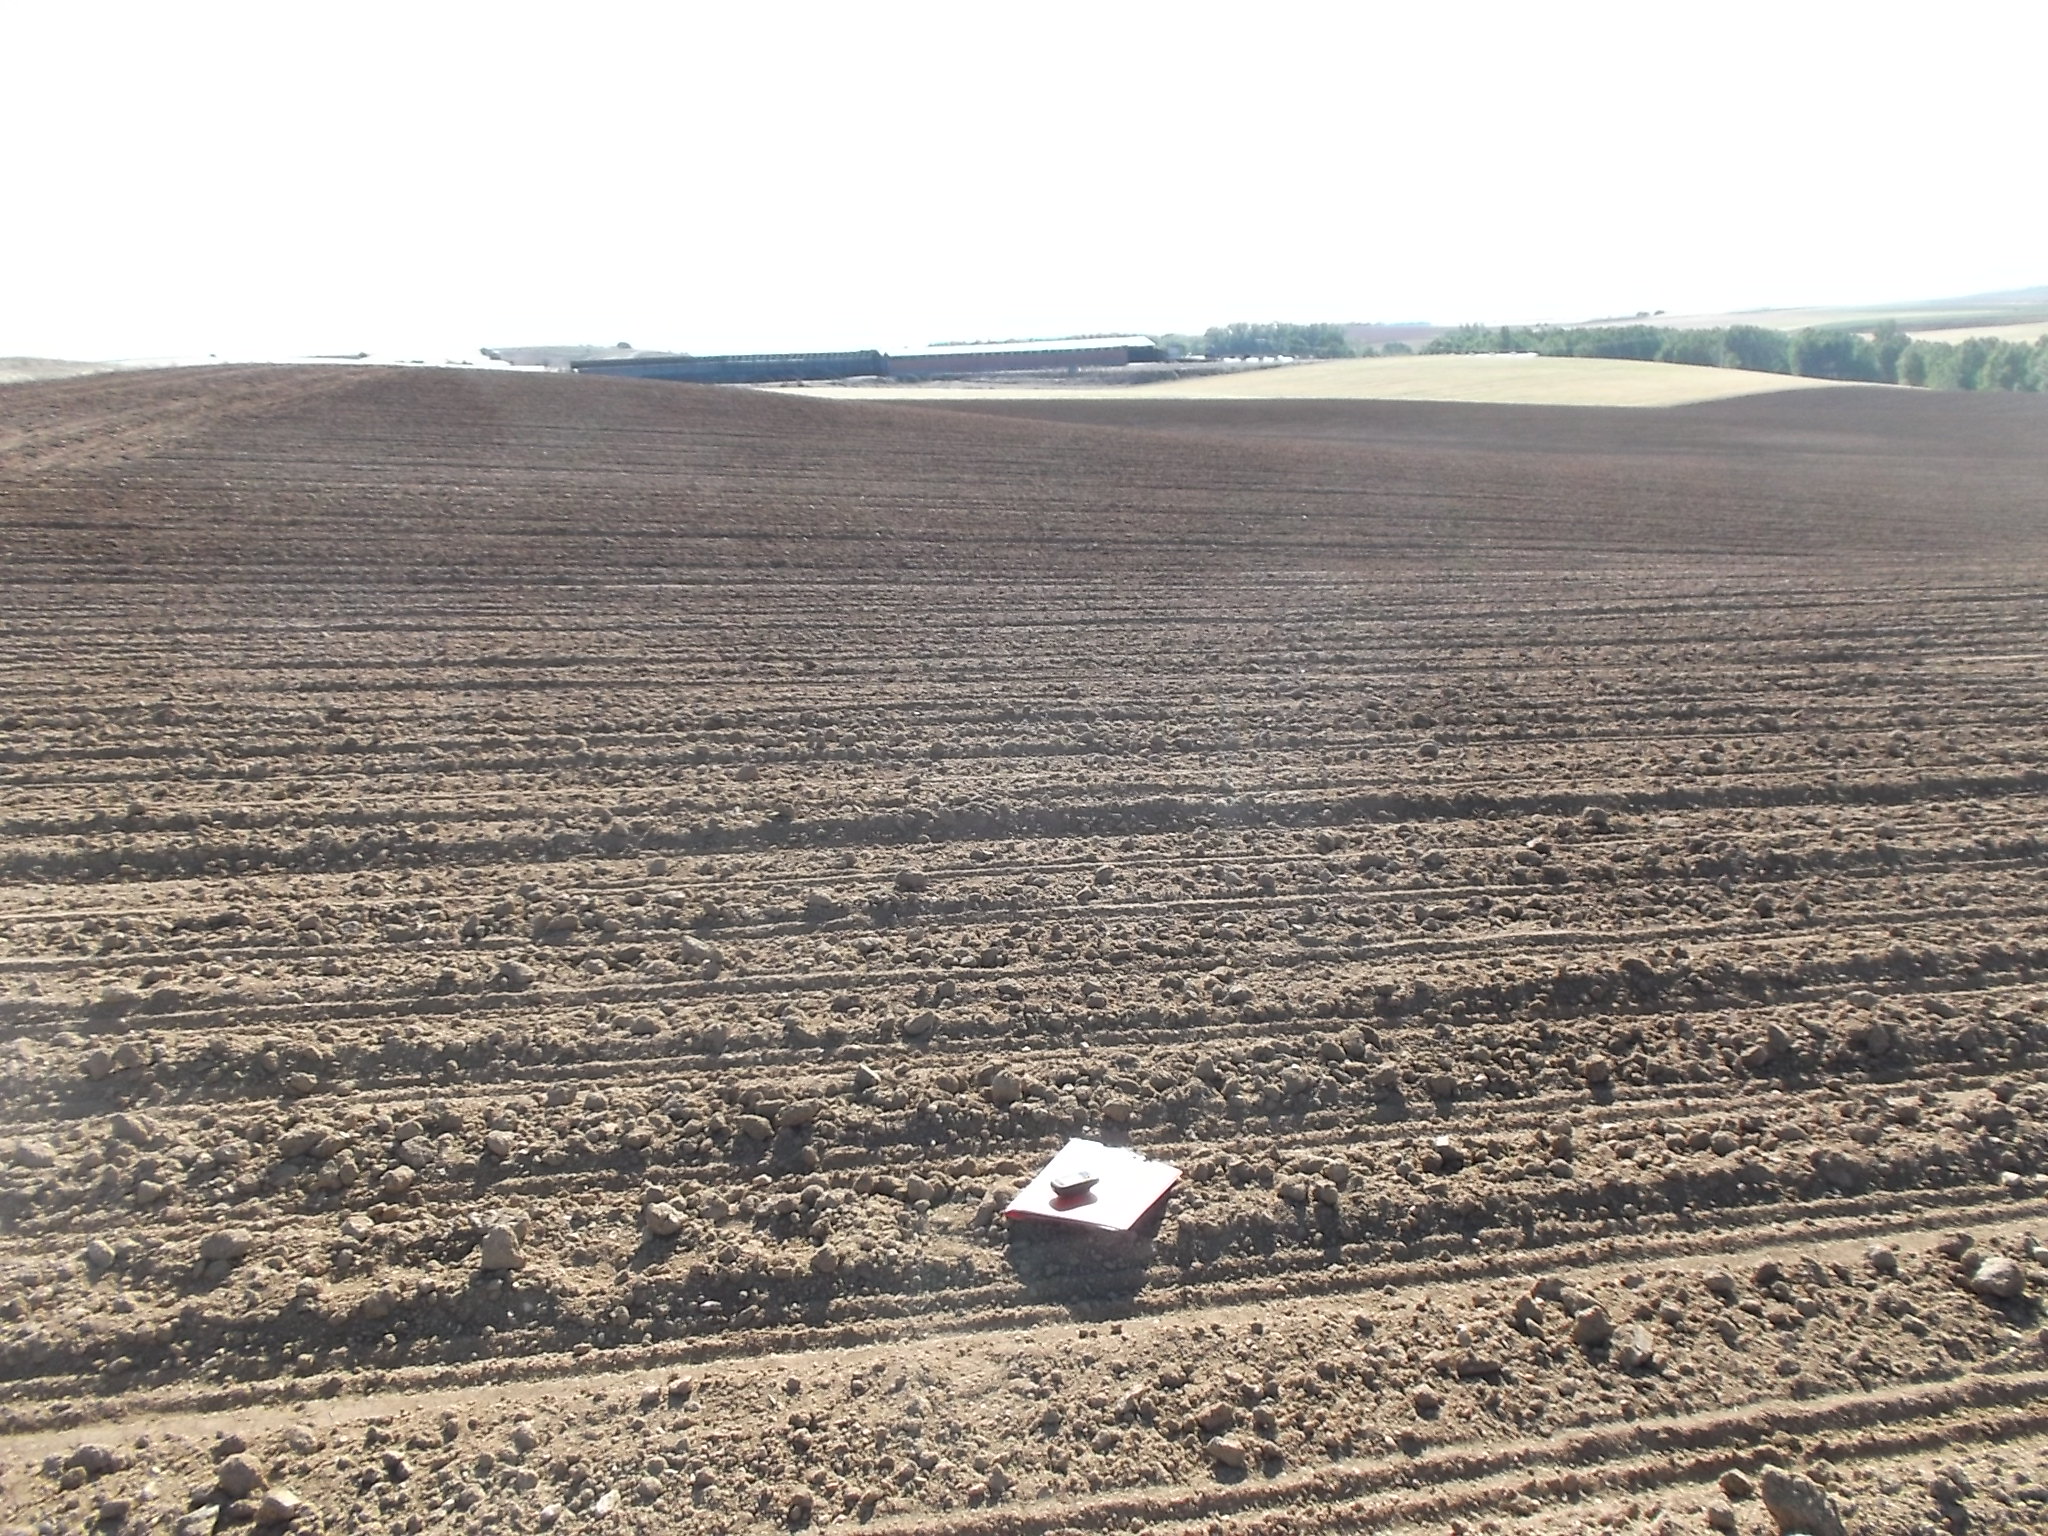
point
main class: Cropland
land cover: Sunflower
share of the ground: < 10 %
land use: Agriculture (excluding fallow land and kitchen gardens)
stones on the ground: < 10 %
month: May
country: ES
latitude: 41.1579
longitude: -5.3879
